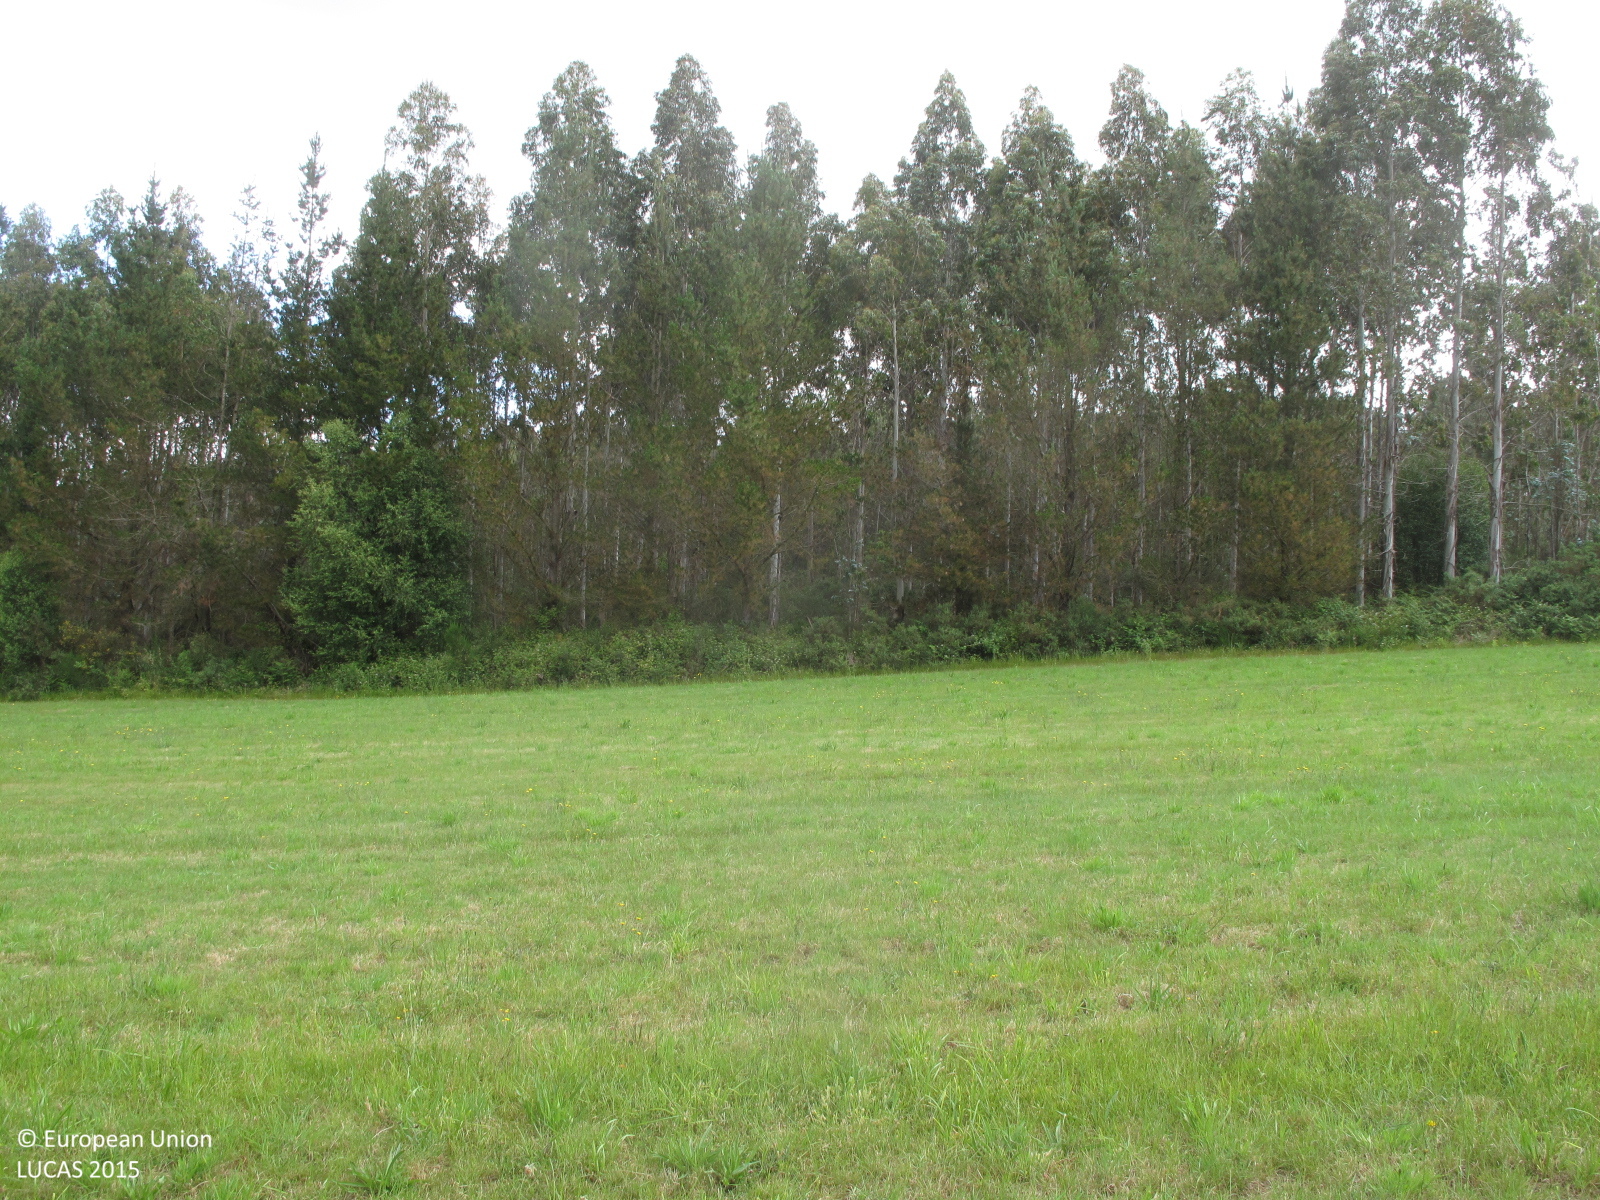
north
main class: Woodland
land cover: Other mixed woodland
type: exotic forest
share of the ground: 50 - 75 %
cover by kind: shrubs 40 %, broadleaved forest trees 30 %, coniferous forest trees 20 %, herbaceous plants 10 %
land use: Forestry
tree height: > 5 m
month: June
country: ES
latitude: 43.1159
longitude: -8.5808
